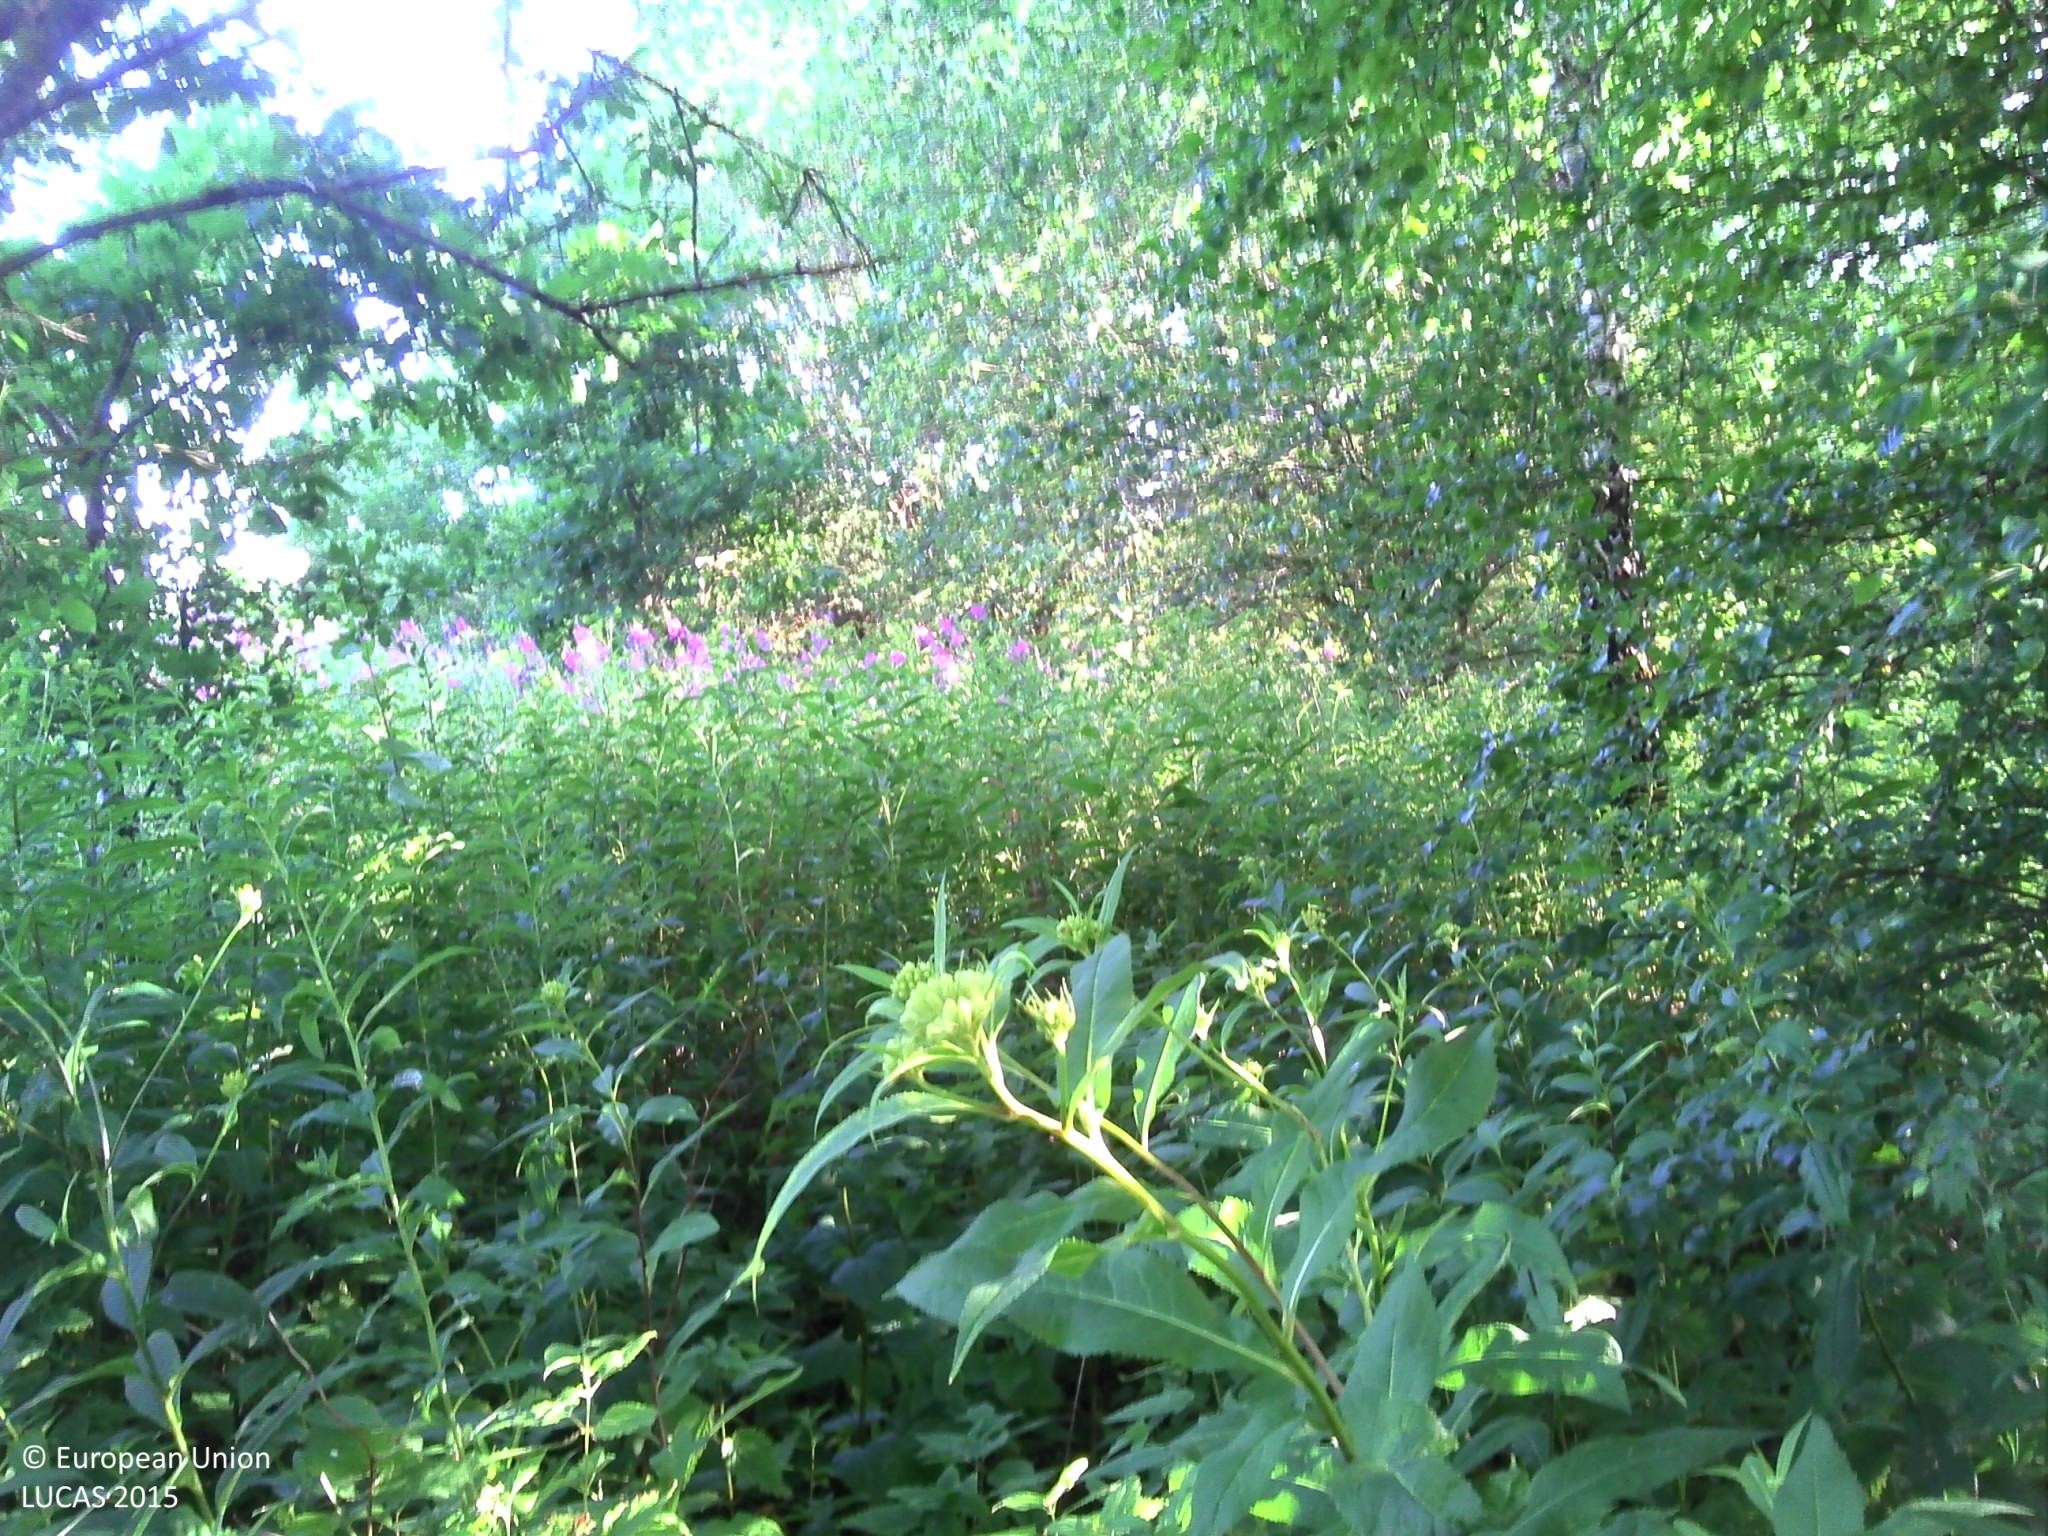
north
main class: Woodland
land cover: Broadleaved woodland
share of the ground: > 75 %
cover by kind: broadleaved forest trees 95 %, herbaceous plants 5 %
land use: Semi-natural and natural areas not in use
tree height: > 5 m
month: July
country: BE
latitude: 50.0116
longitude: 5.6588
